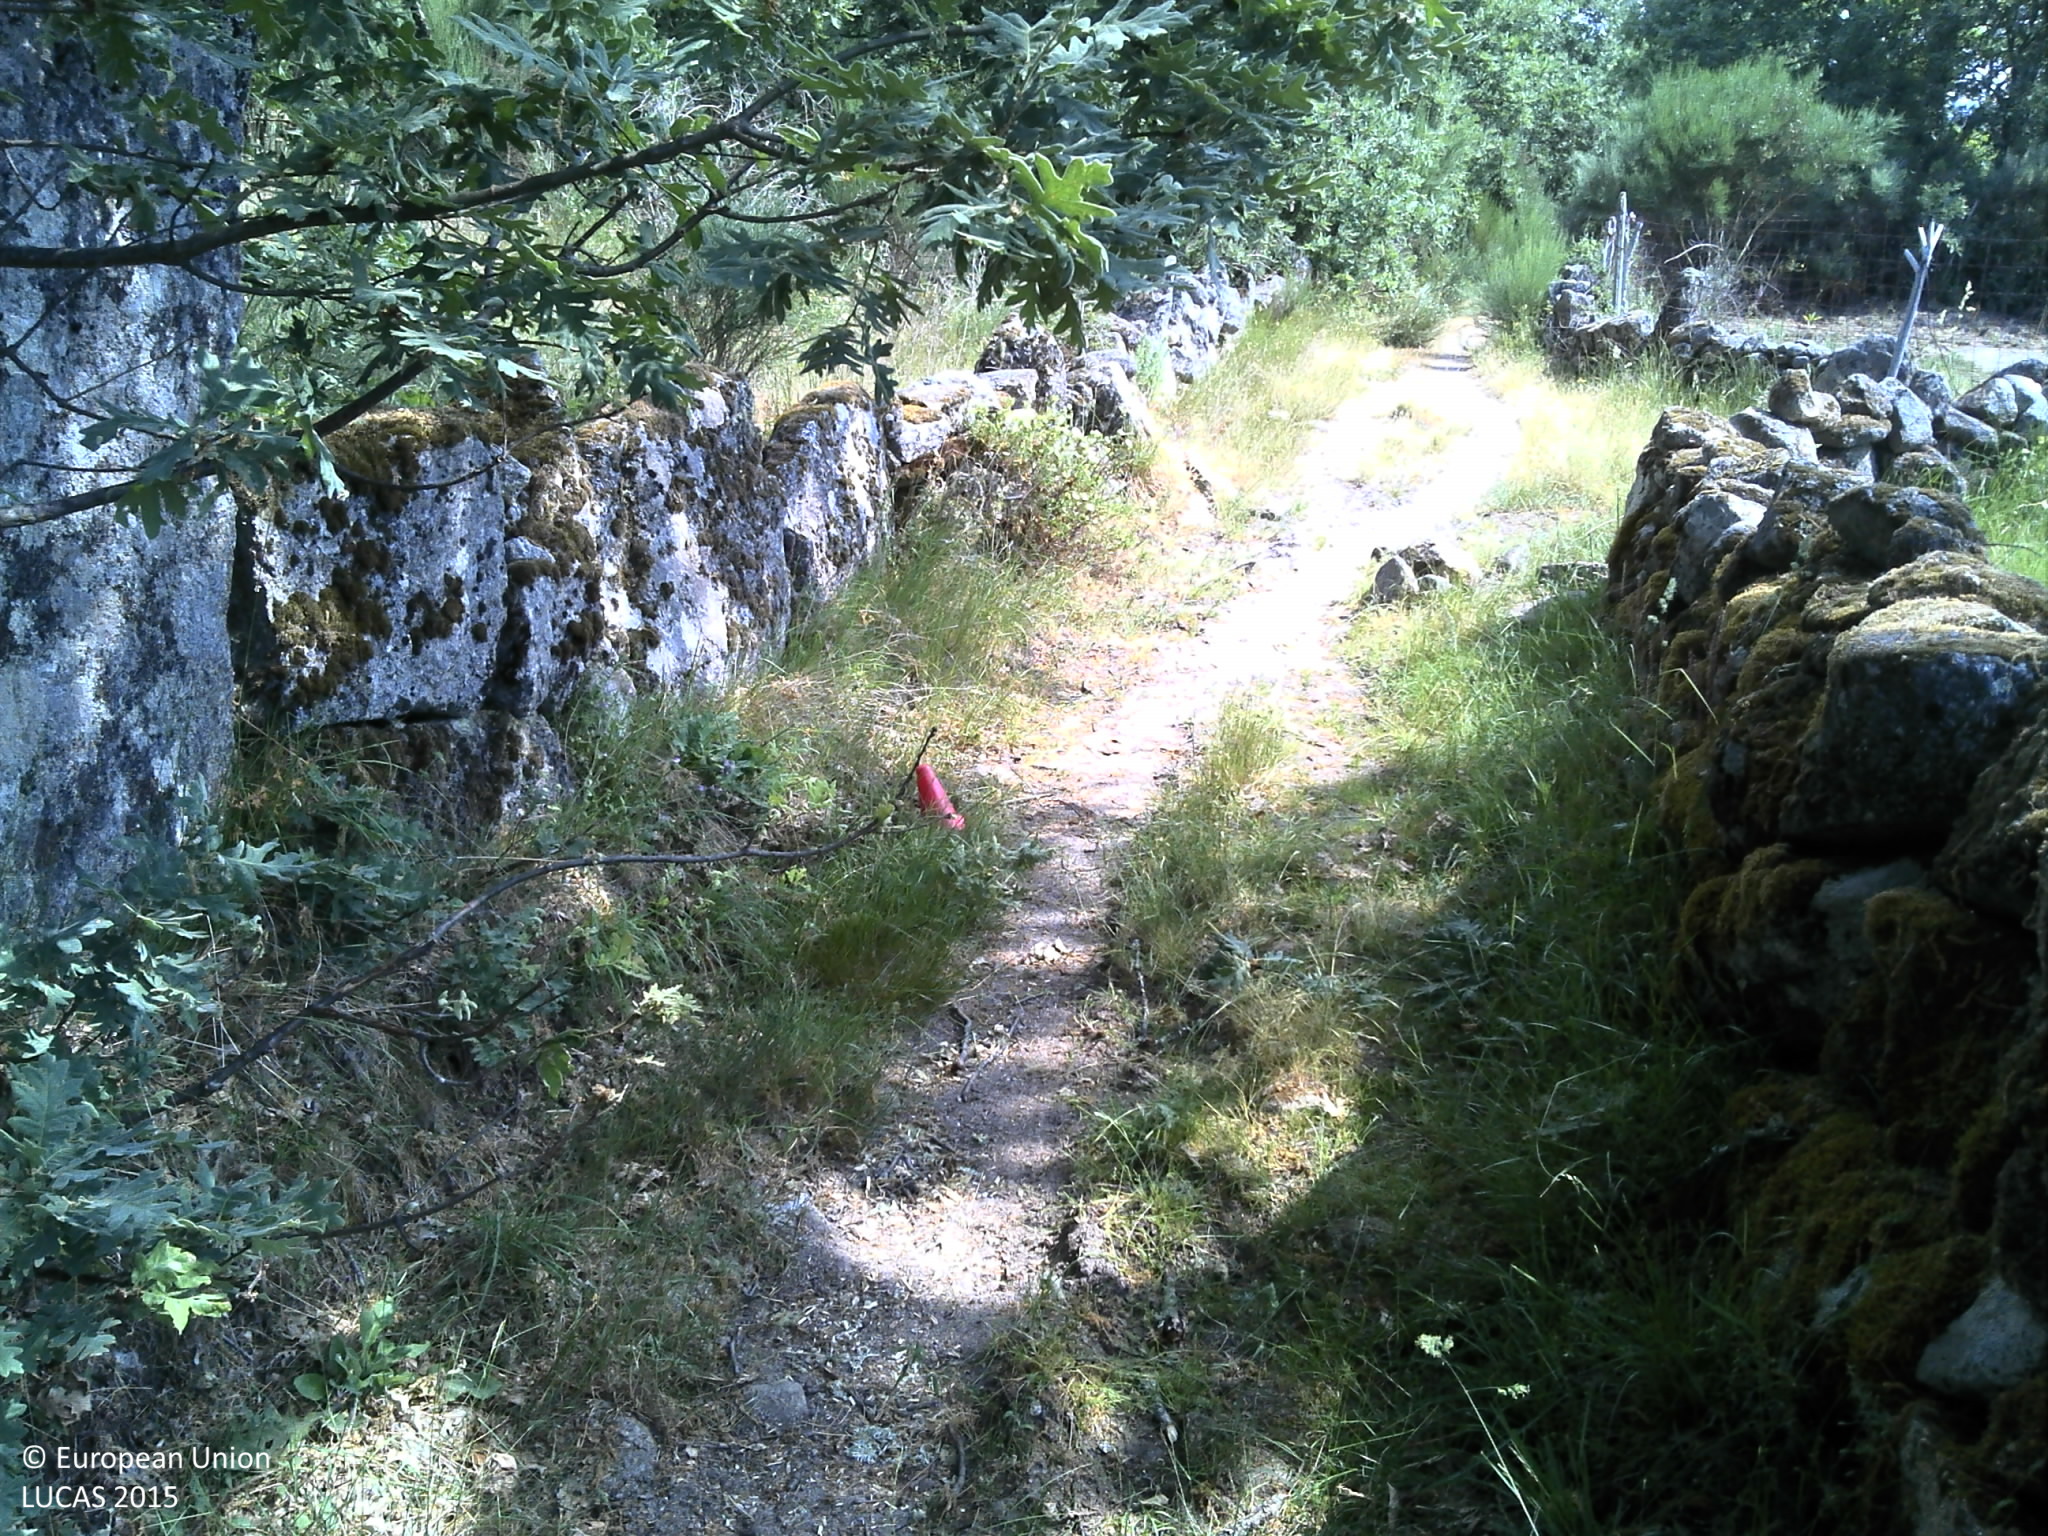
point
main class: Woodland
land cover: Broadleaved woodland
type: thermophilous deciduous forest
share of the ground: 50 - 75 %
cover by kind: broadleaved forest trees 50 %, shrubs 20 %, herbaceous plants 20 %, unconsolidated bare surface 10 %
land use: Abandoned areas
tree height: > 5 m
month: June
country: PT
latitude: 41.4542
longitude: -7.5702
